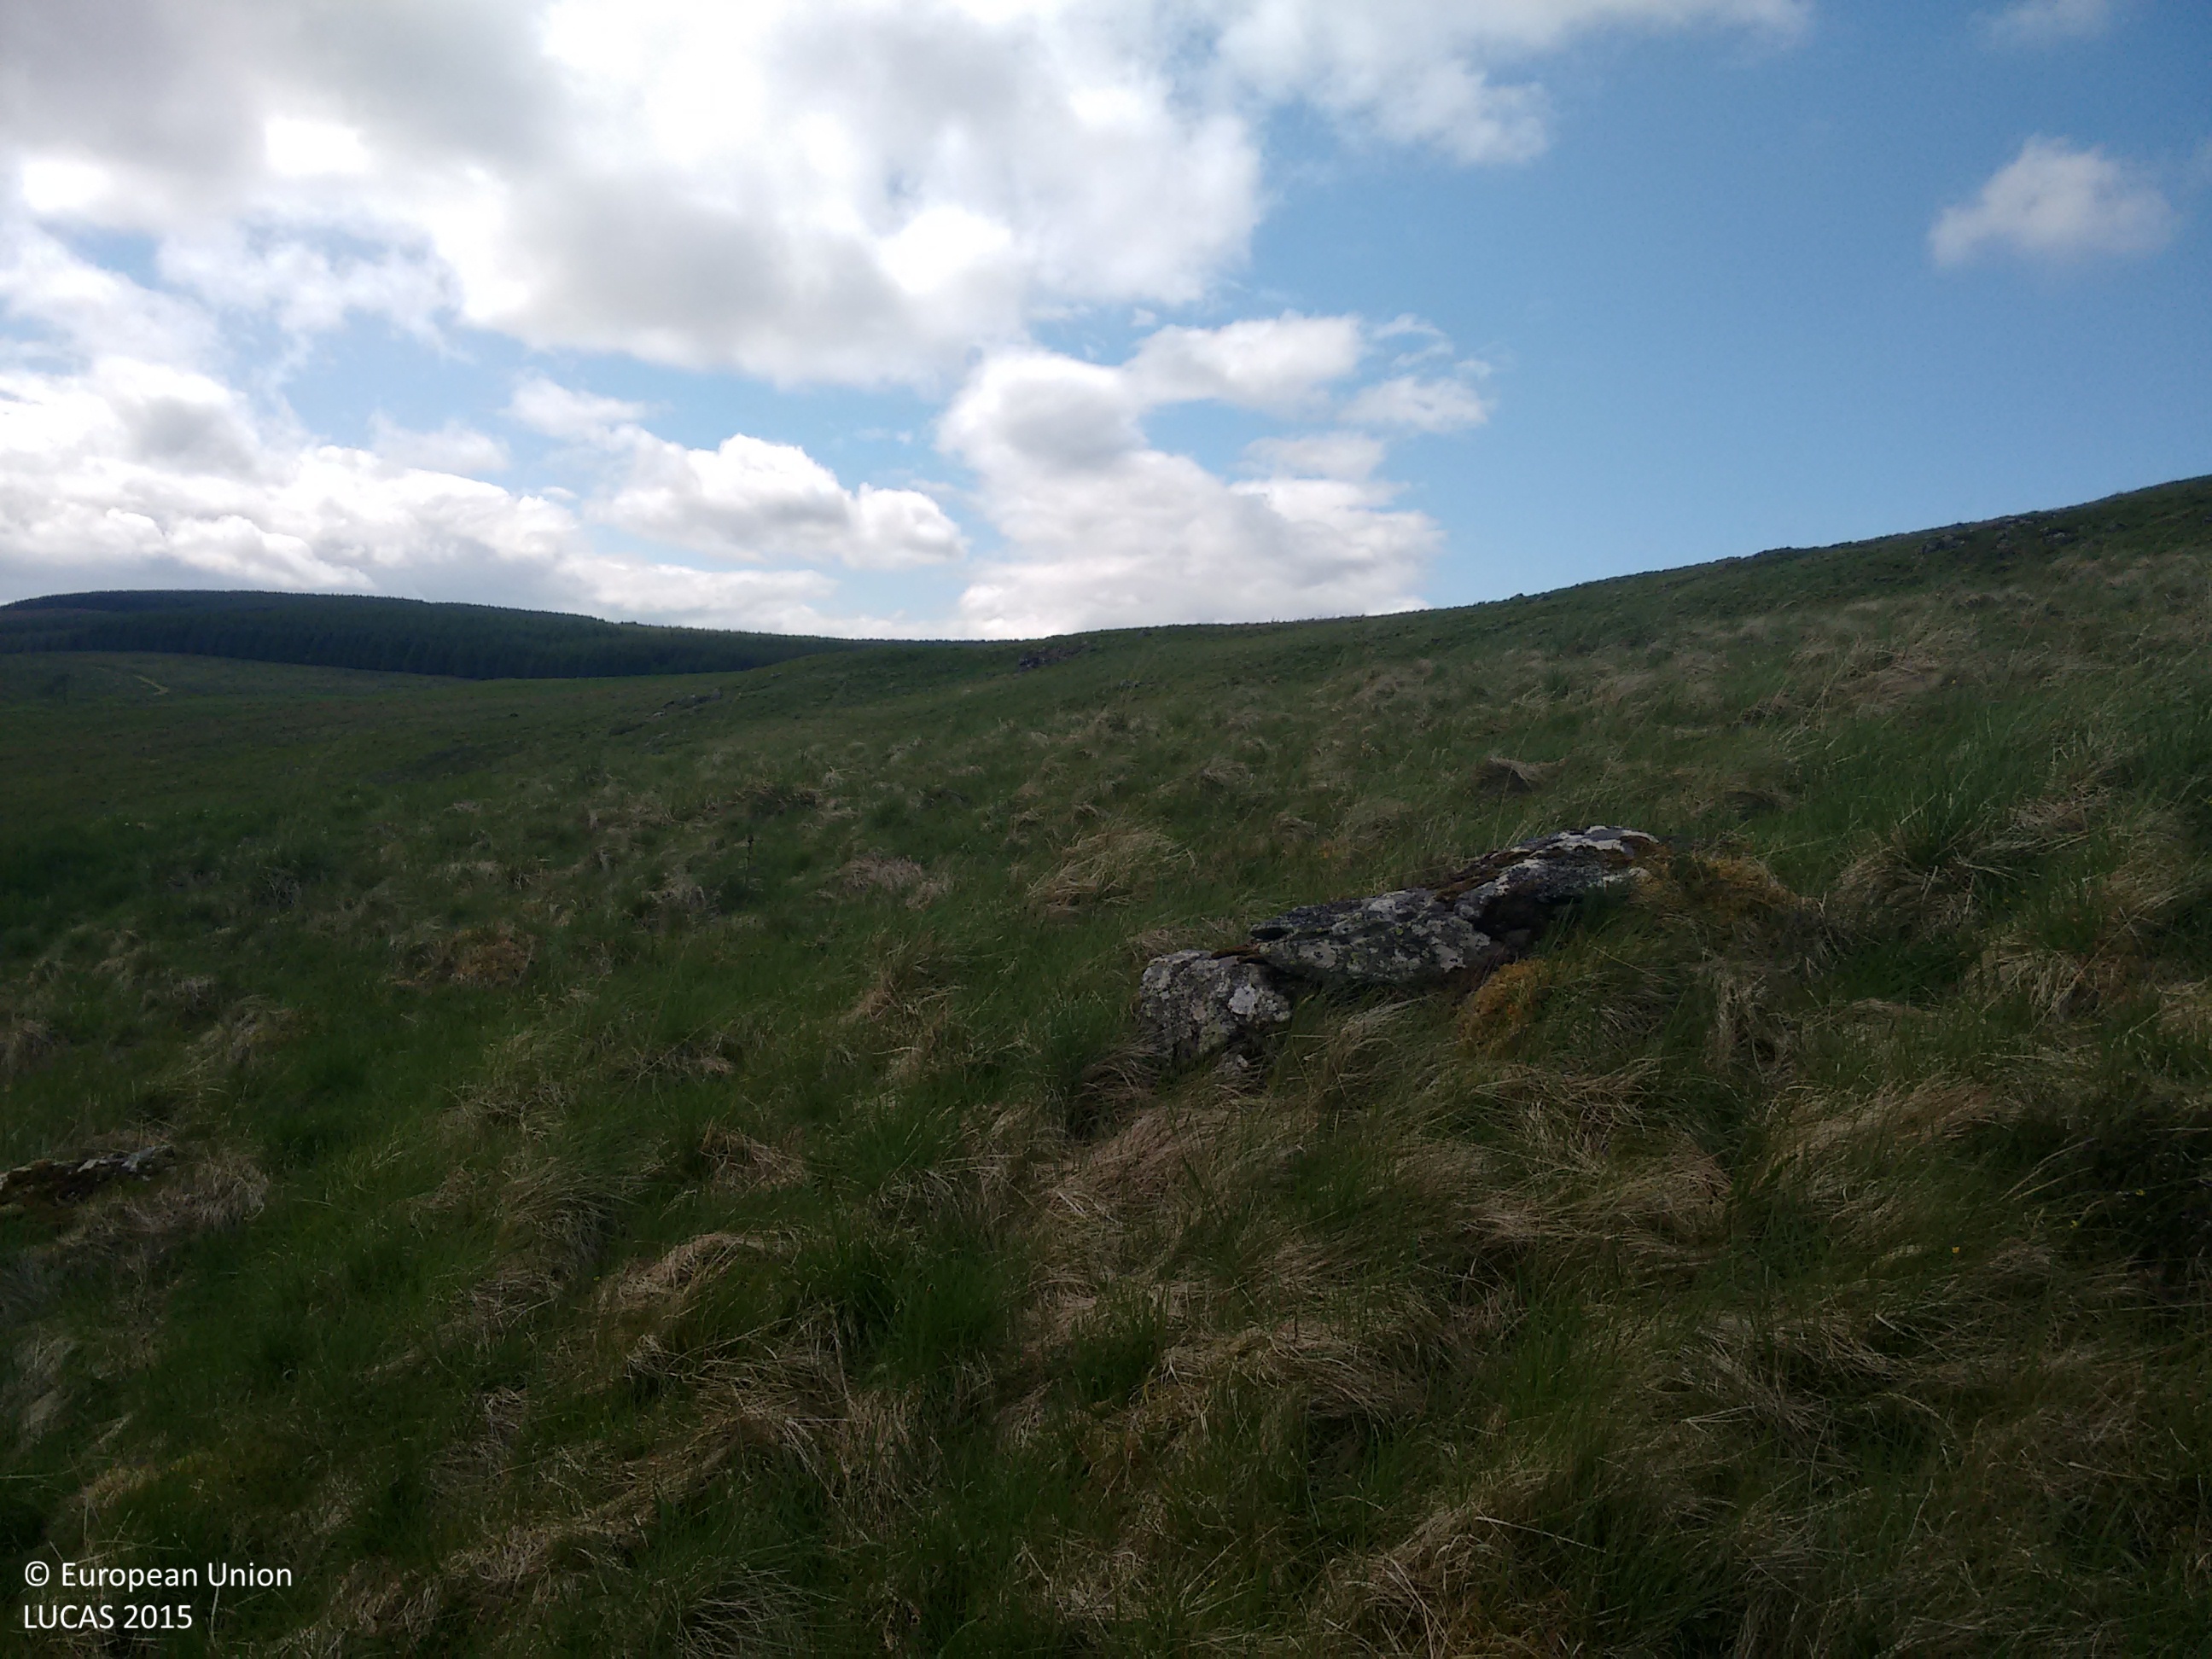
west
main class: Grassland
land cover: Grassland without tree/shrub cover
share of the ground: > 75 %
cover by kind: herbaceous plants 100 %
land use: Agriculture (excluding fallow land and kitchen gardens)
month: June
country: GB
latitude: 57.4027
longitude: -2.9931
